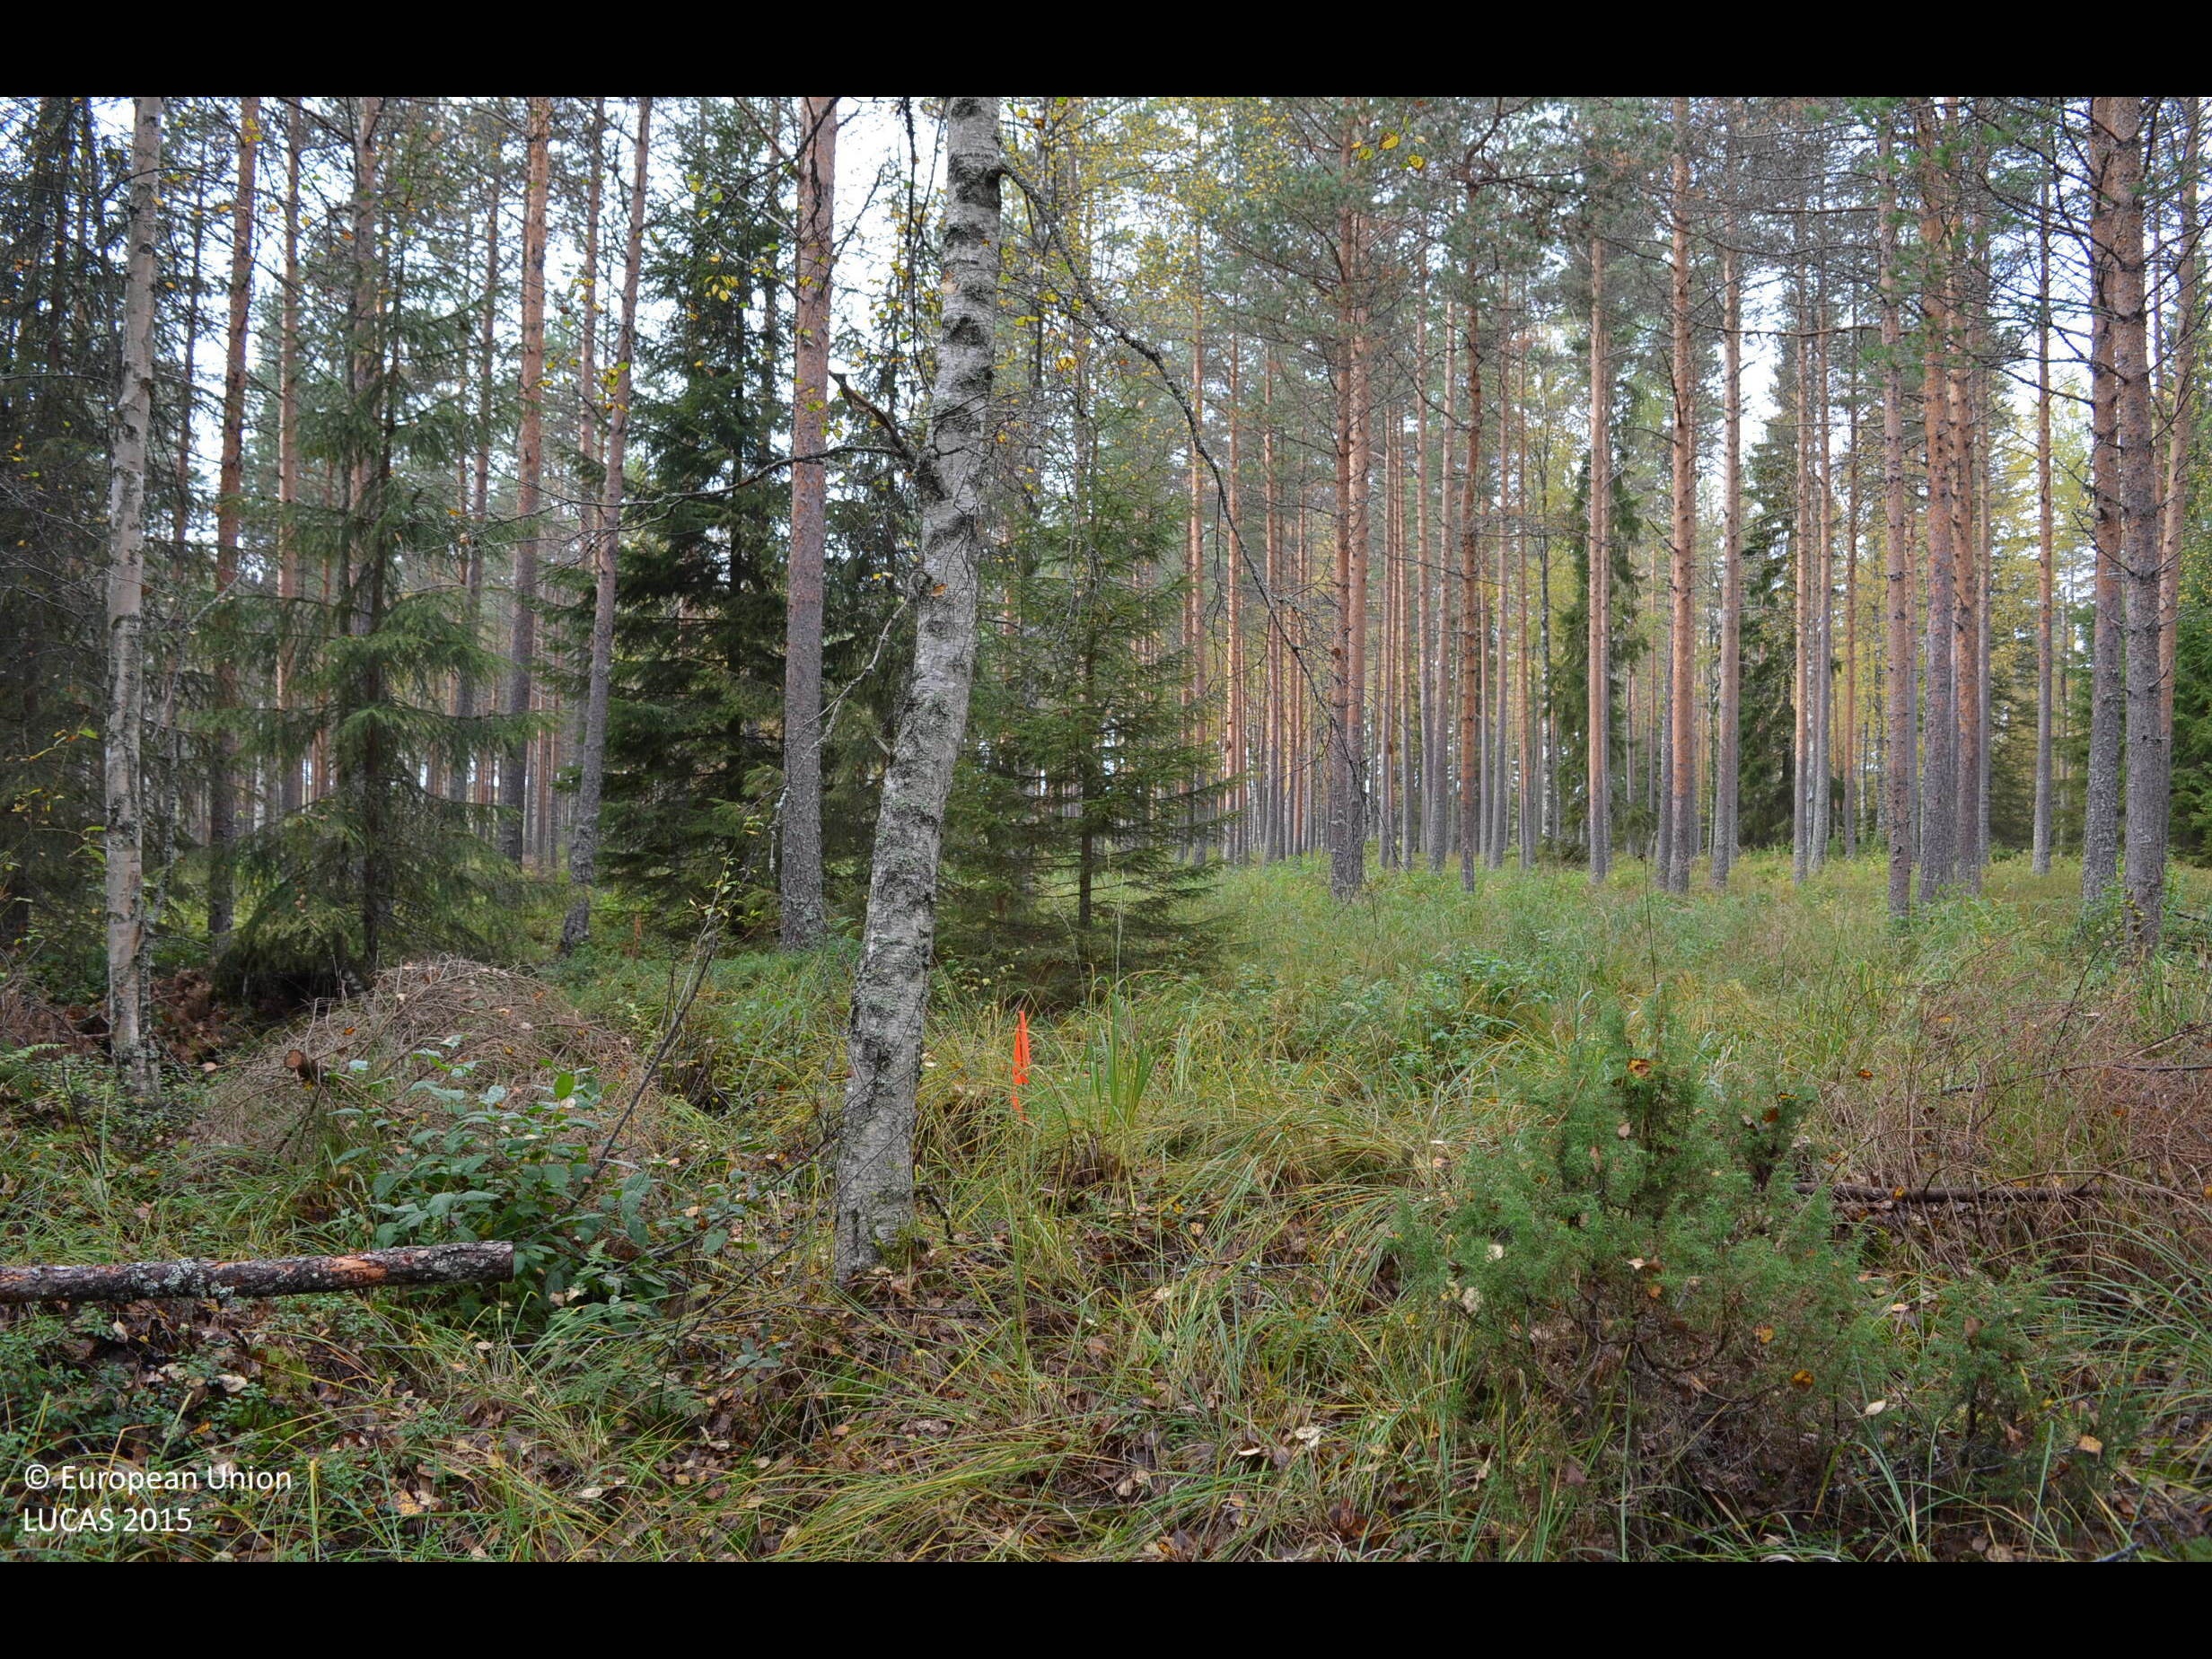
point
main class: Woodland
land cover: Pine dominated mixed woodland
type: boreal forest
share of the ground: > 75 %
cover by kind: coniferous forest trees 55 %, broadleaved forest trees 20 %, herbaceous plants 15 %, shrubs 10 %
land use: Forestry
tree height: > 5 m
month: September
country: FI
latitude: 62.6951
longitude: 23.7320
